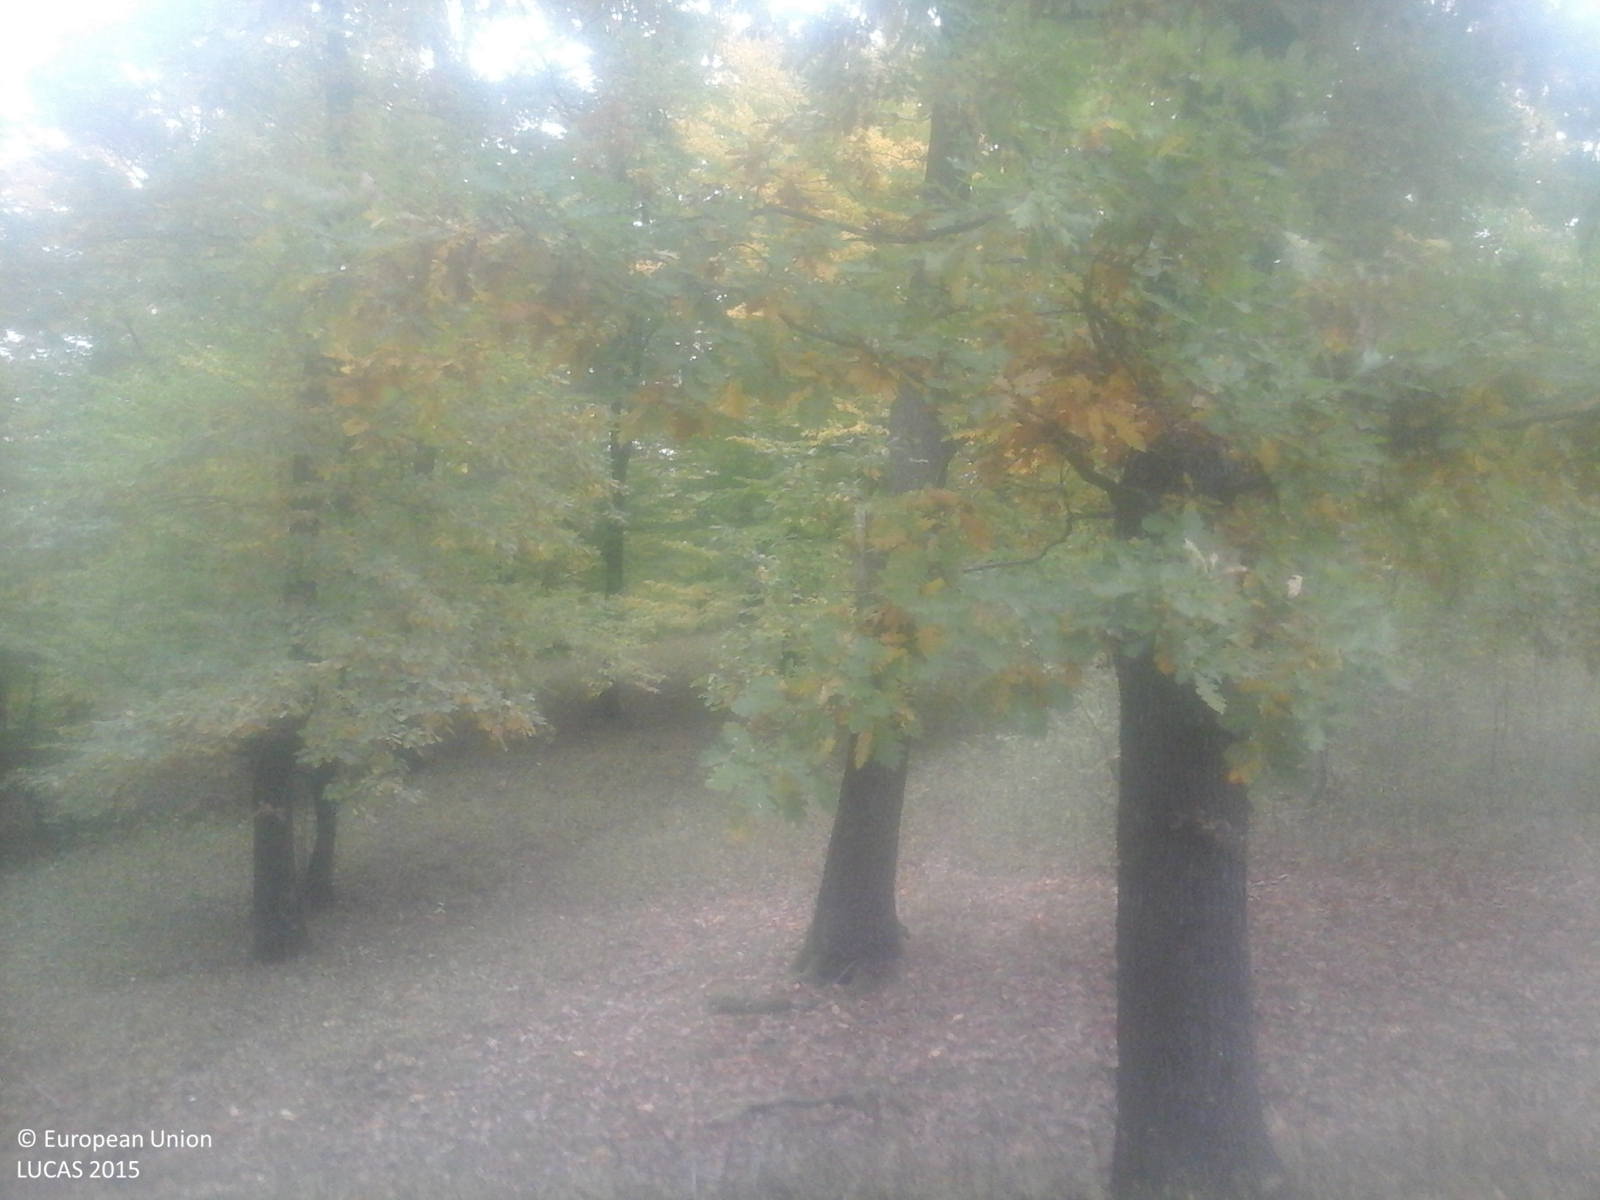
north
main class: Woodland
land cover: Broadleaved woodland
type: acidophilous oak and oak-birch forest
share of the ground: > 75 %
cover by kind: broadleaved forest trees 100 %
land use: Forestry
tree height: > 5 m
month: October
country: RO
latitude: 45.0319
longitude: 25.7270
